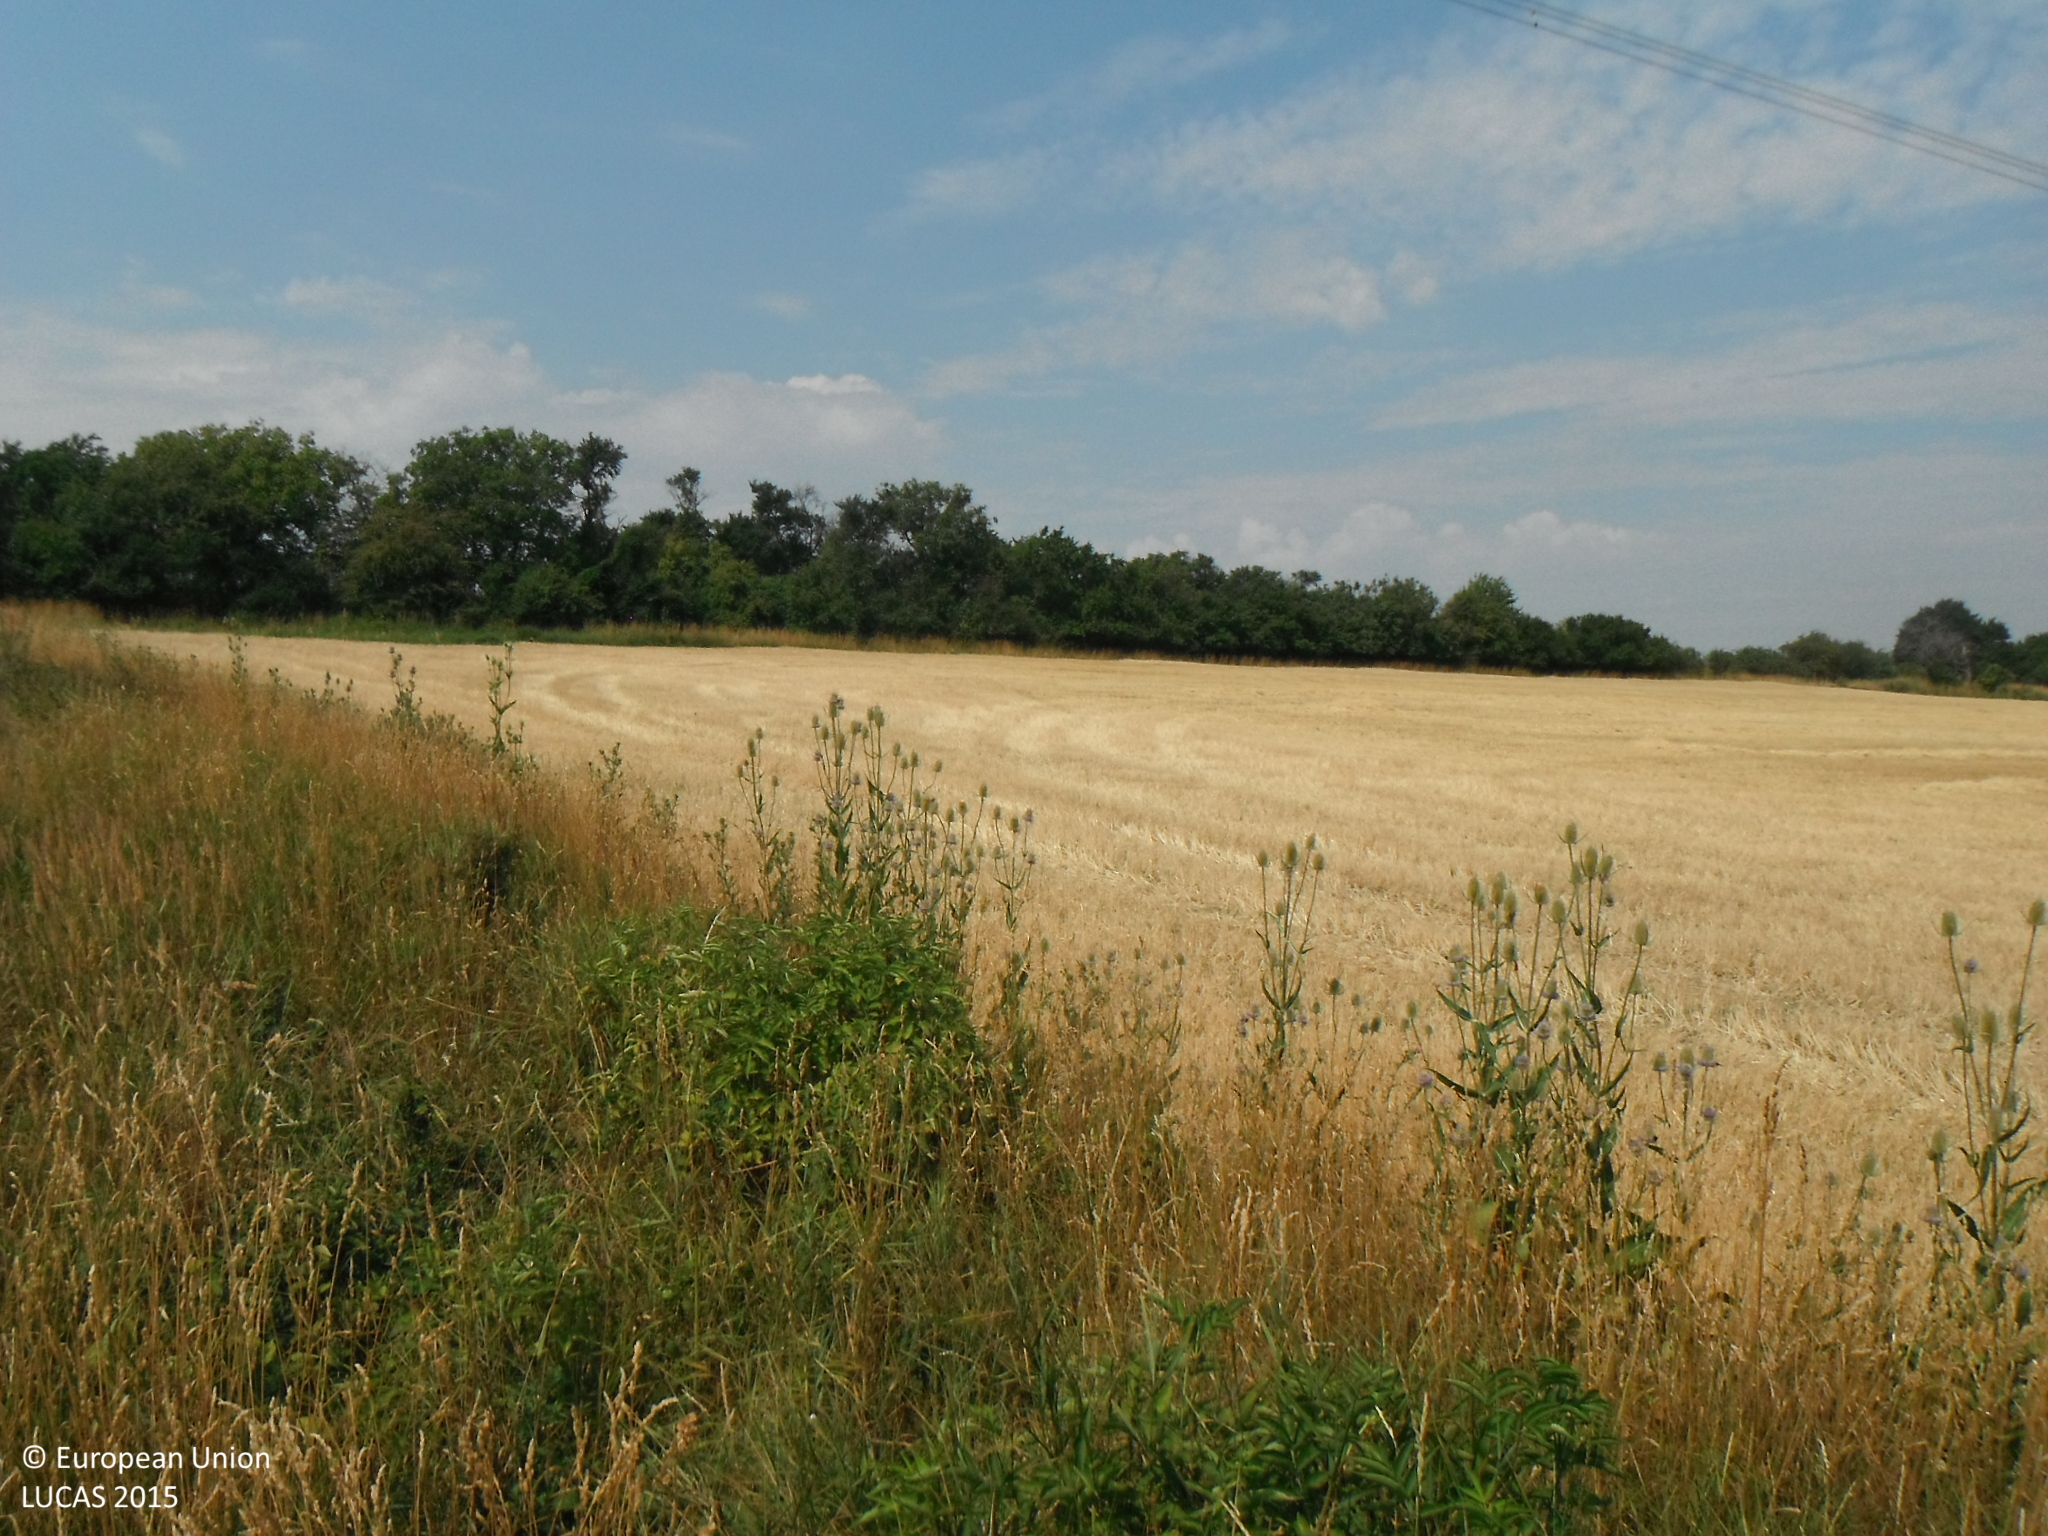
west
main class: Grassland
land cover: Spontaneously vegetated surfaces
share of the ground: > 75 %
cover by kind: herbaceous plants 95 %, shrubs 5 %
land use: Semi-natural and natural areas not in use
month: July
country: SK
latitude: 48.8323
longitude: 17.2711
